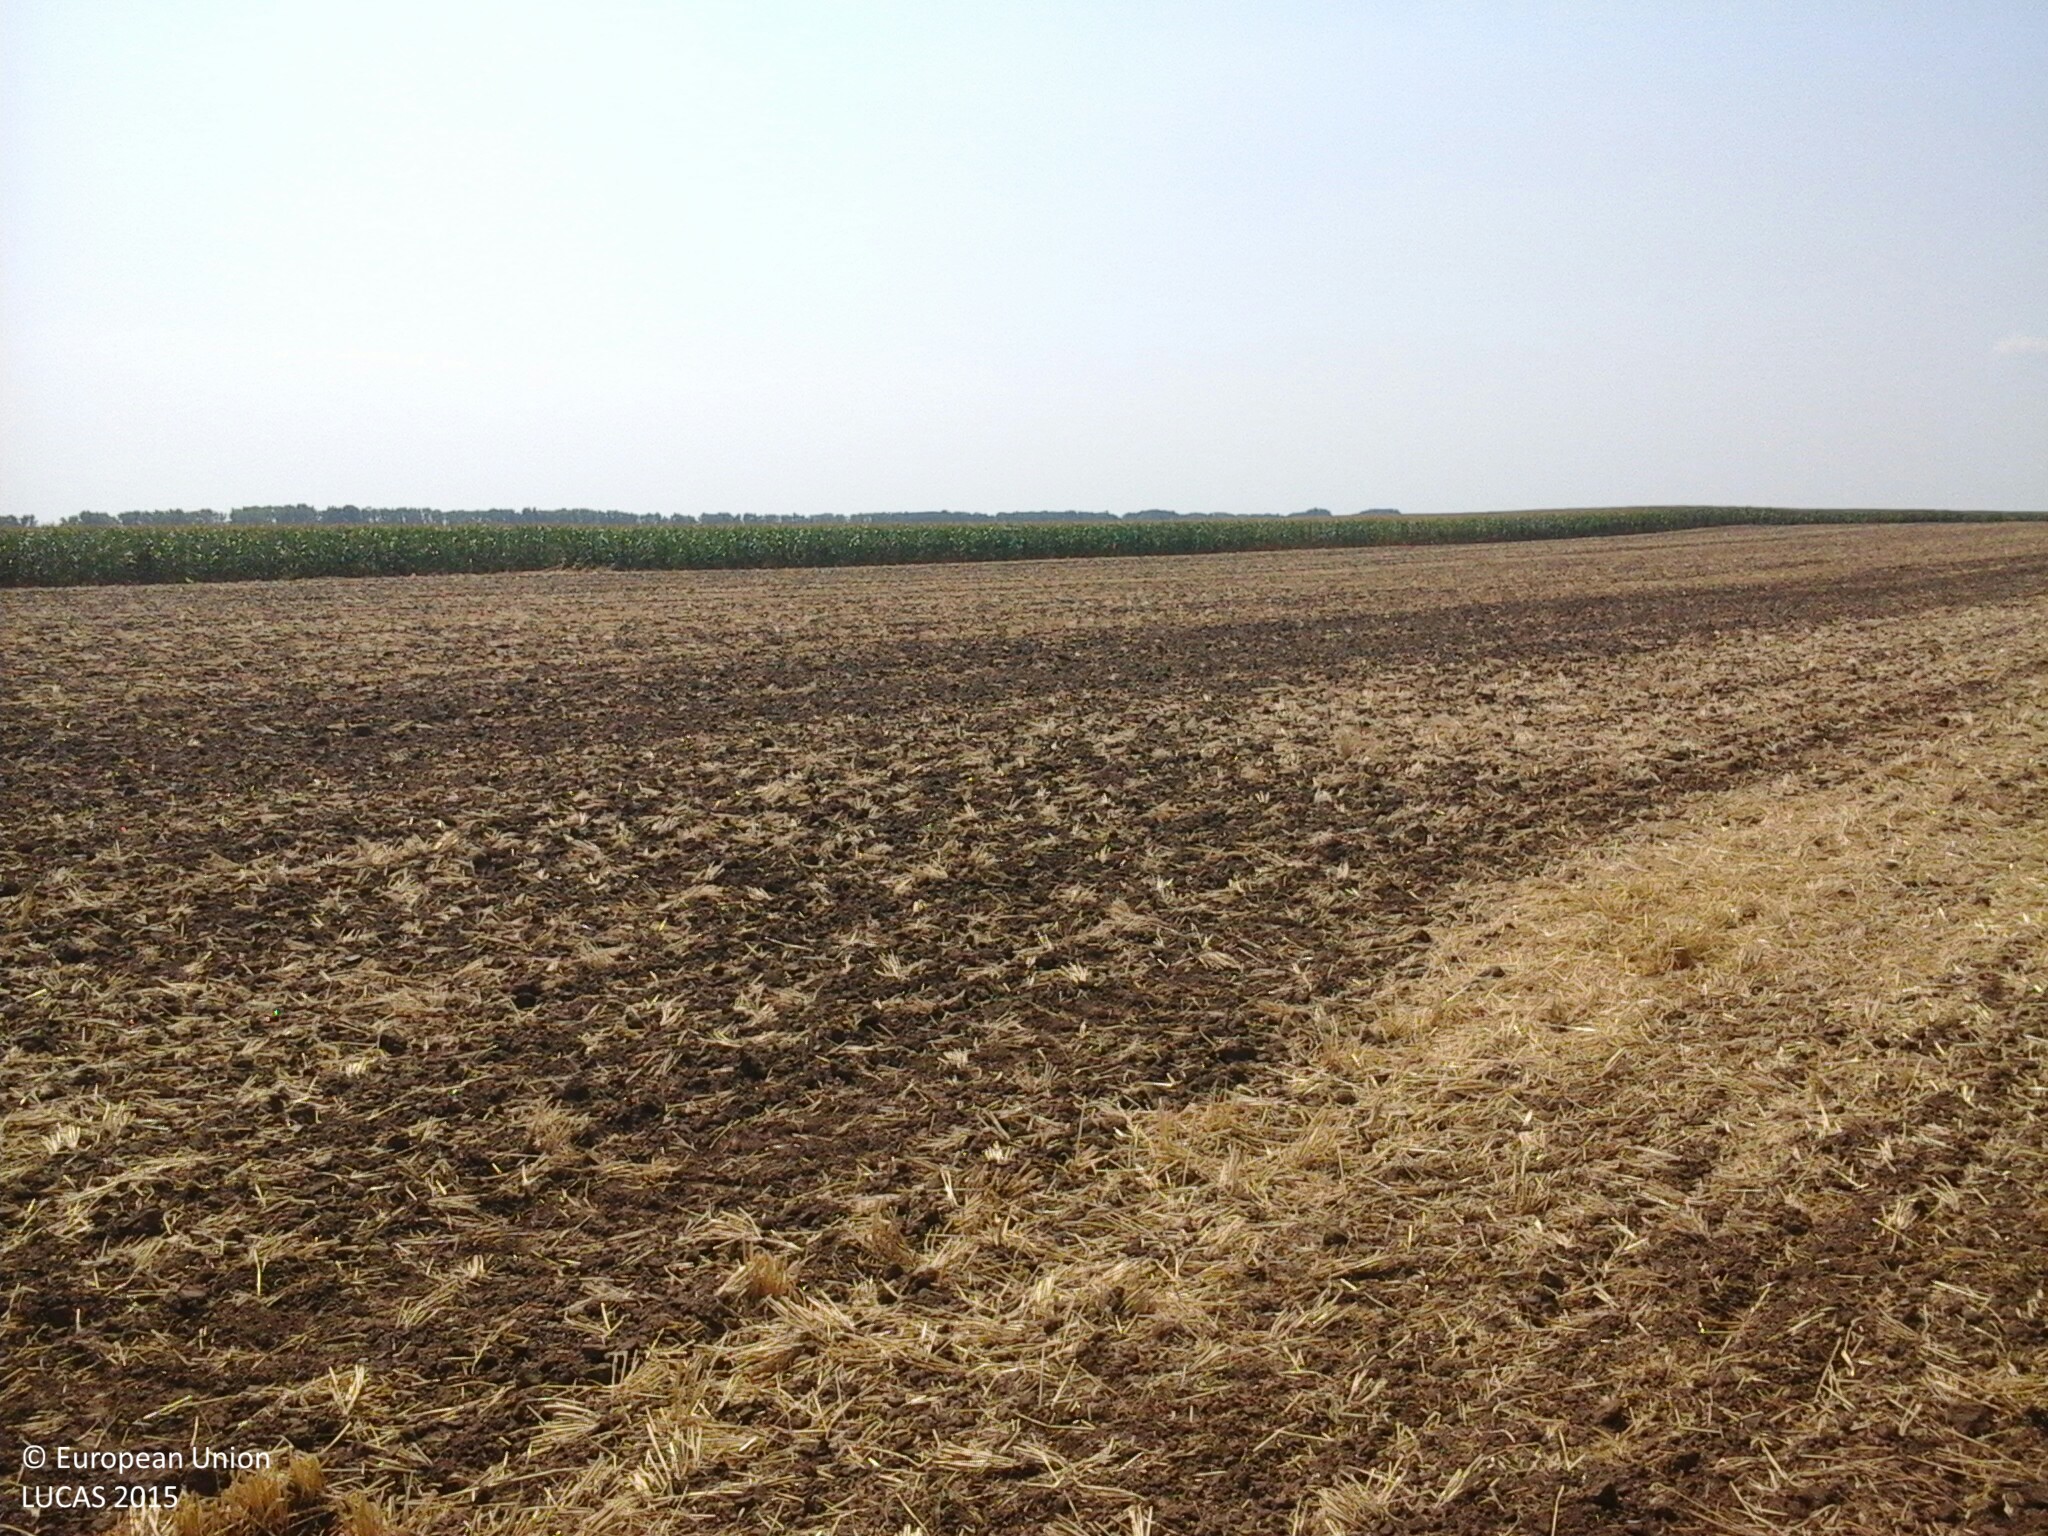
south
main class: Cropland
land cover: Common wheat
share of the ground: < 10 %
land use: Agriculture (excluding fallow land and kitchen gardens)
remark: Harvested field
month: August
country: HU
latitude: 46.9670
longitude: 18.3305
